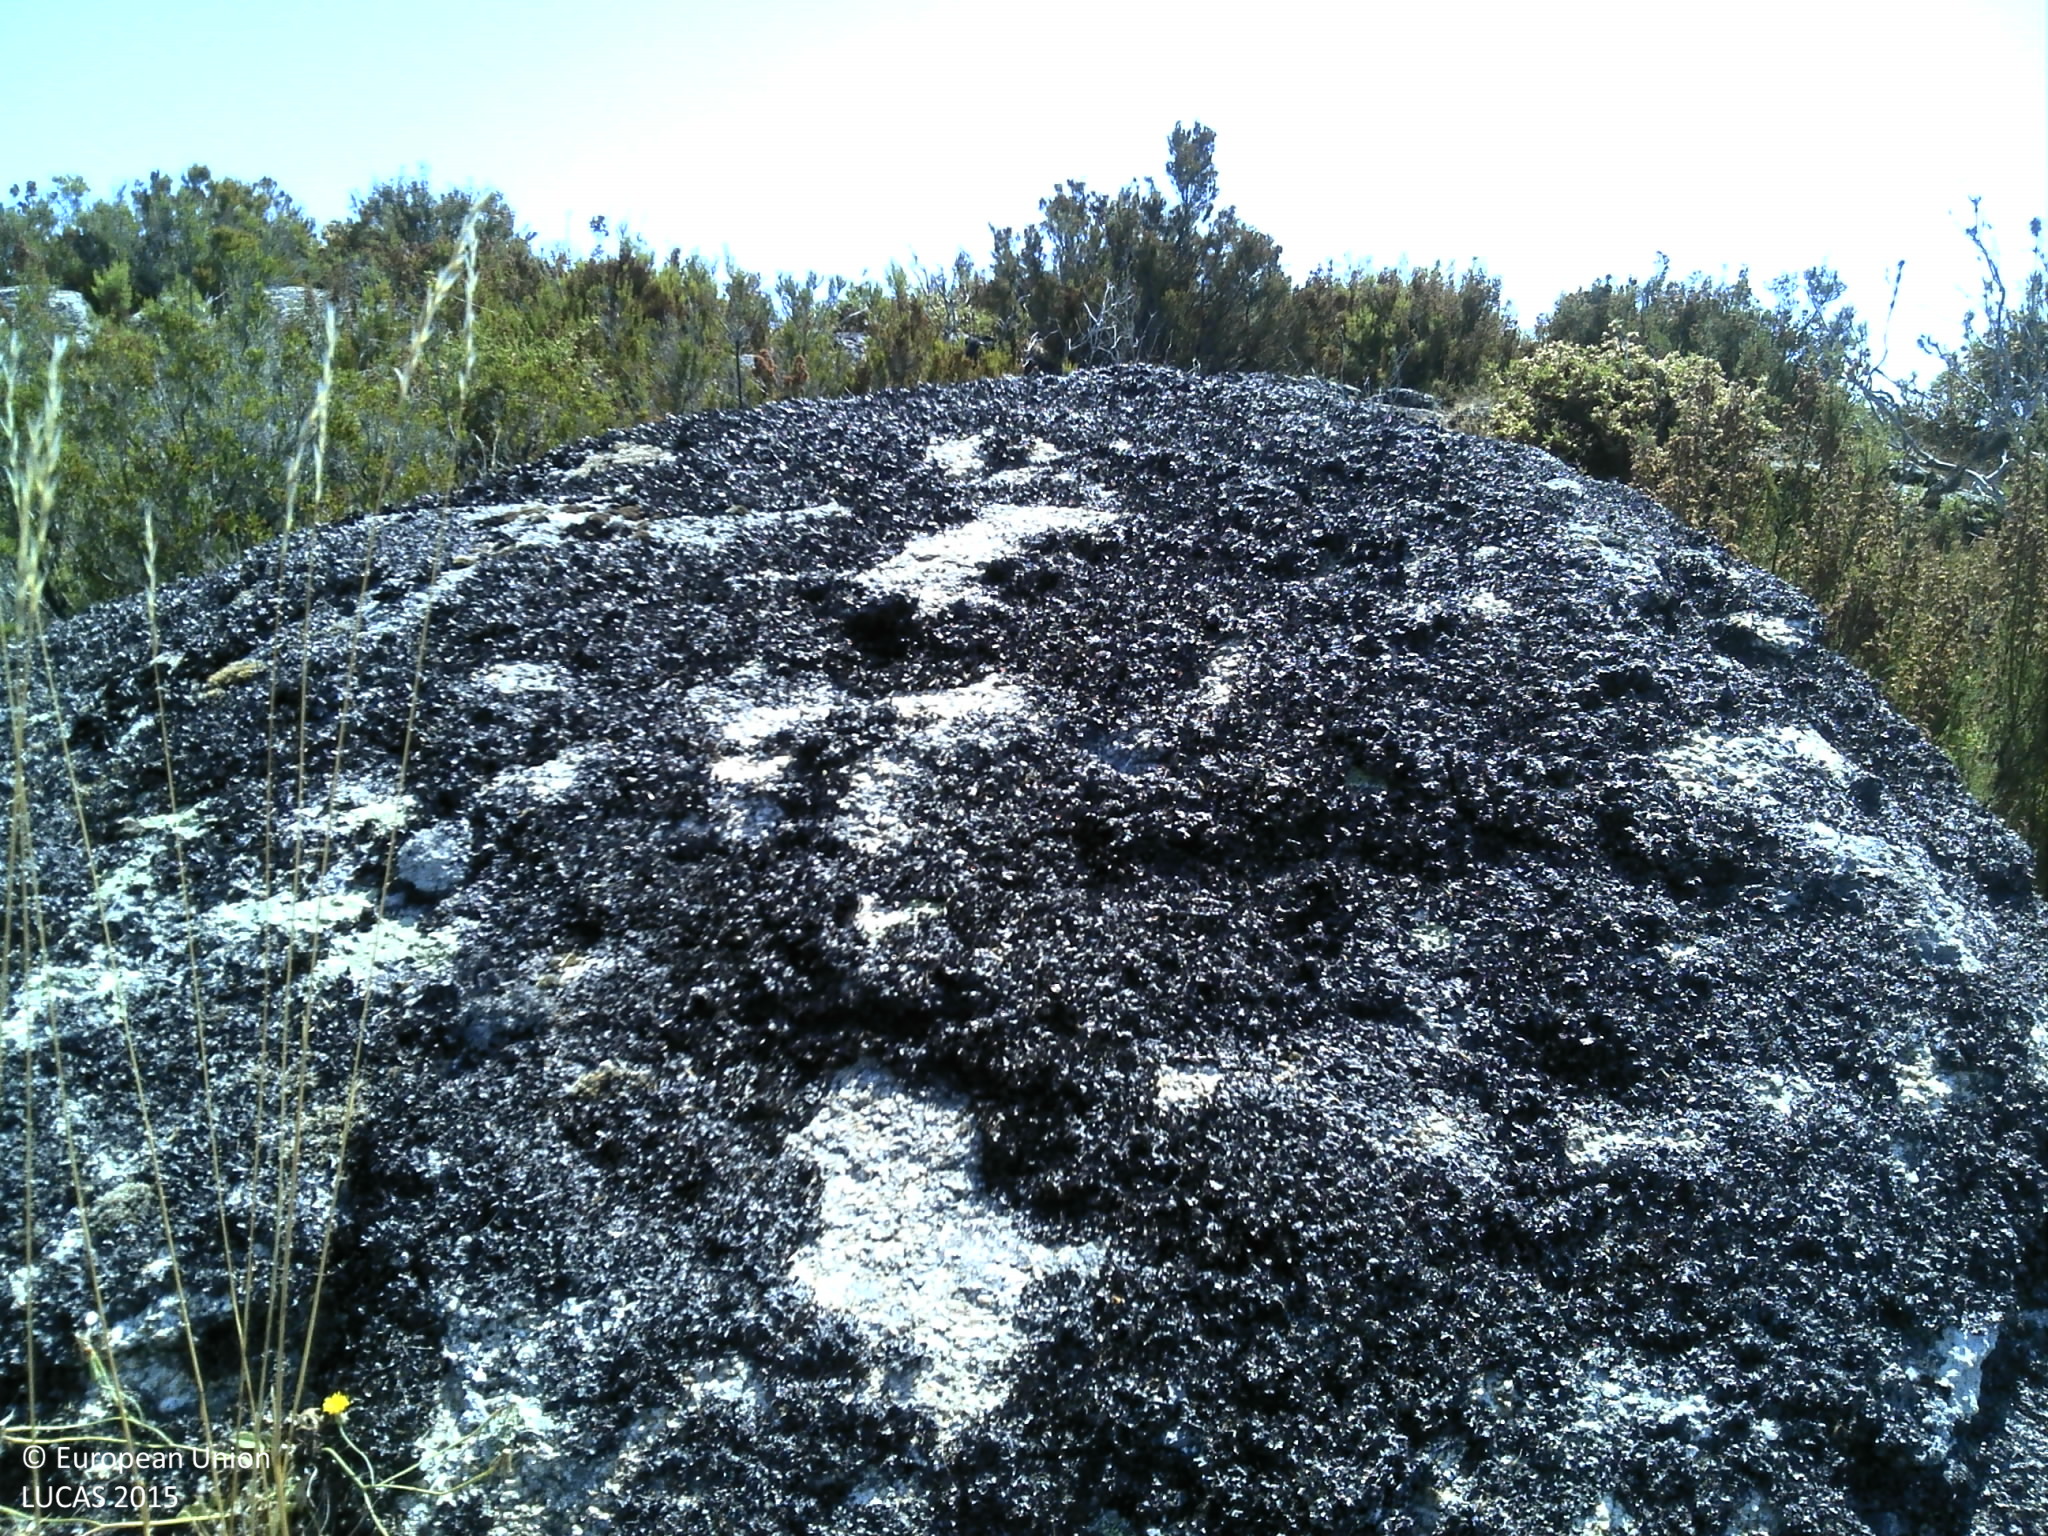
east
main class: Shrubland
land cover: Shrubland without tree cover
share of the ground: > 75 %
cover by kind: shrubs 75 %, consolidated bare surface 25 %
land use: Agriculture (excluding fallow land and kitchen gardens)
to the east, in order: Shrubland without tree cover; Rocks and stones; Shrubland without tree cover; Rocks and stones; Shrubland without tree cover; Rocks and stones
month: July
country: PT
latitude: 41.6748
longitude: -7.8817
